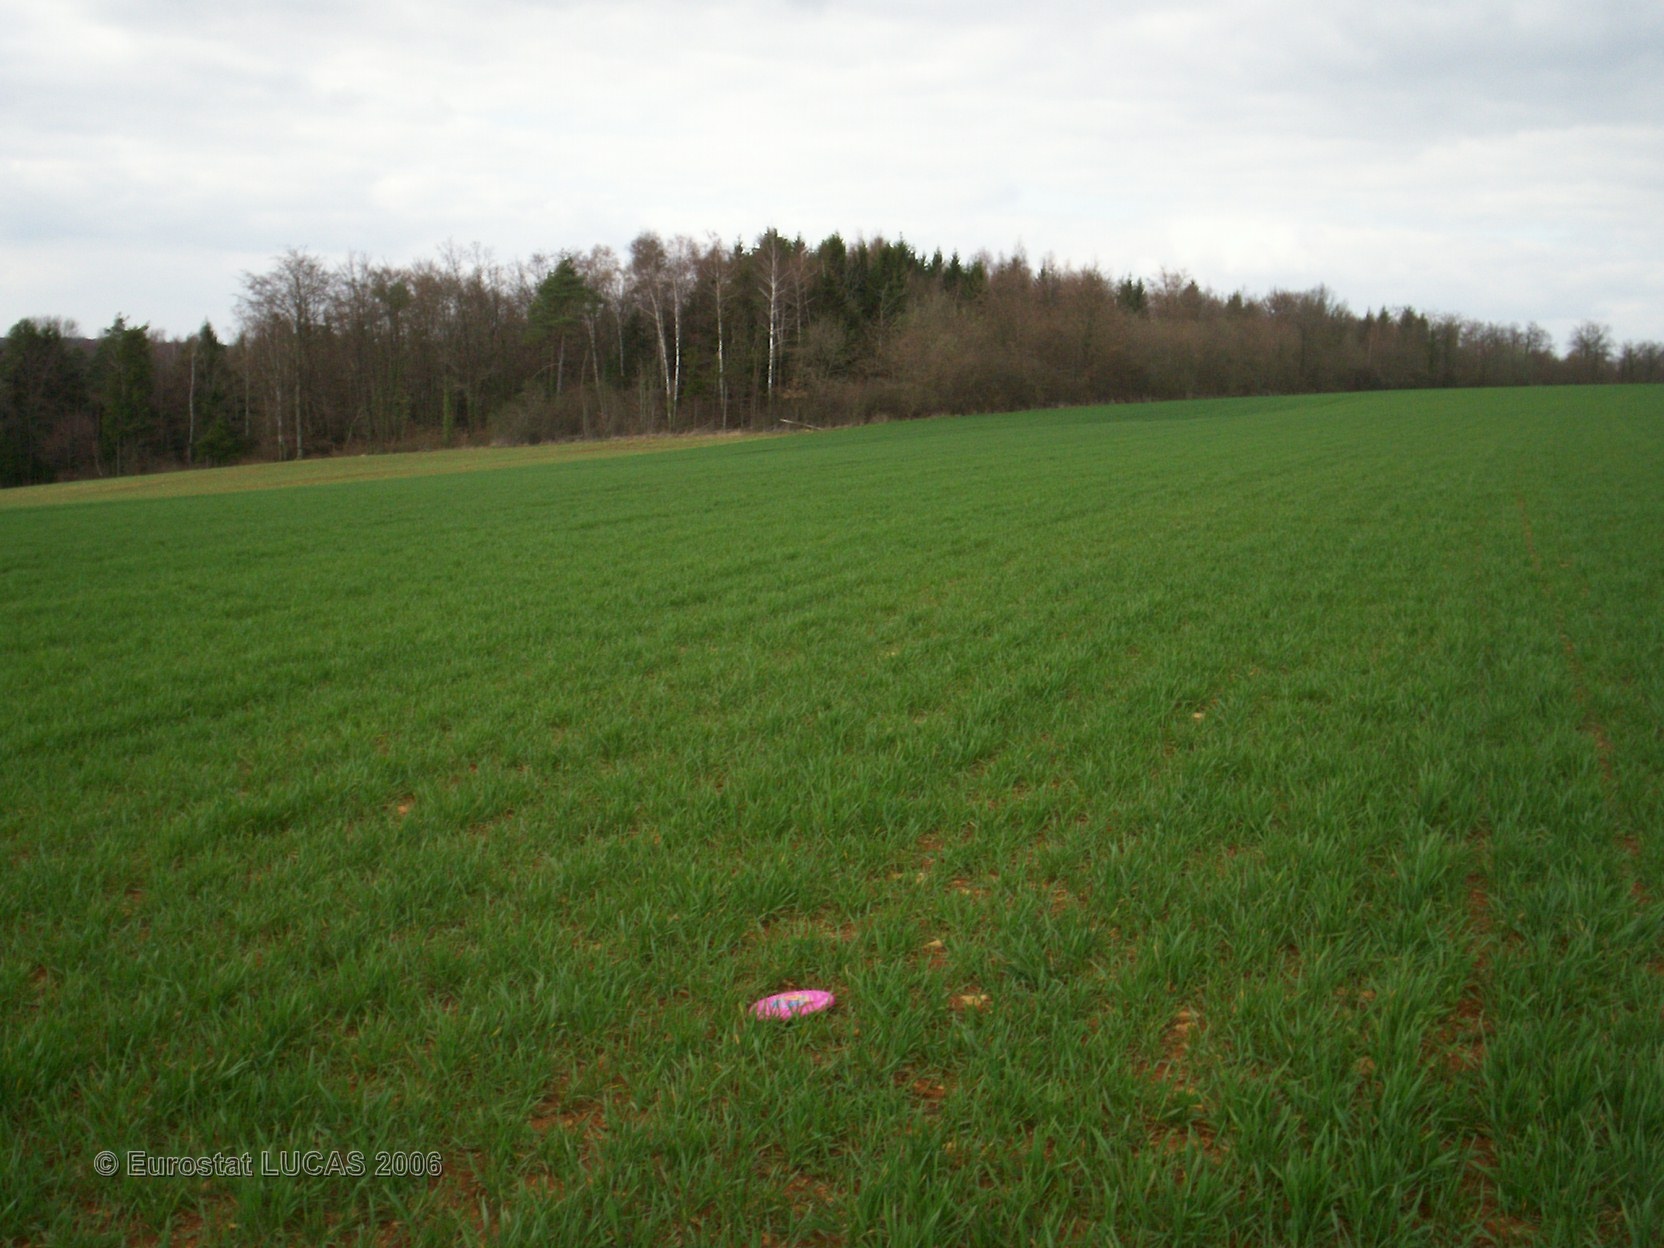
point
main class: Cropland
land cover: Common wheat
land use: Agriculture (excluding fallow land and kitchen gardens)
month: April
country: FR
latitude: 49.5716
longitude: 5.0332
